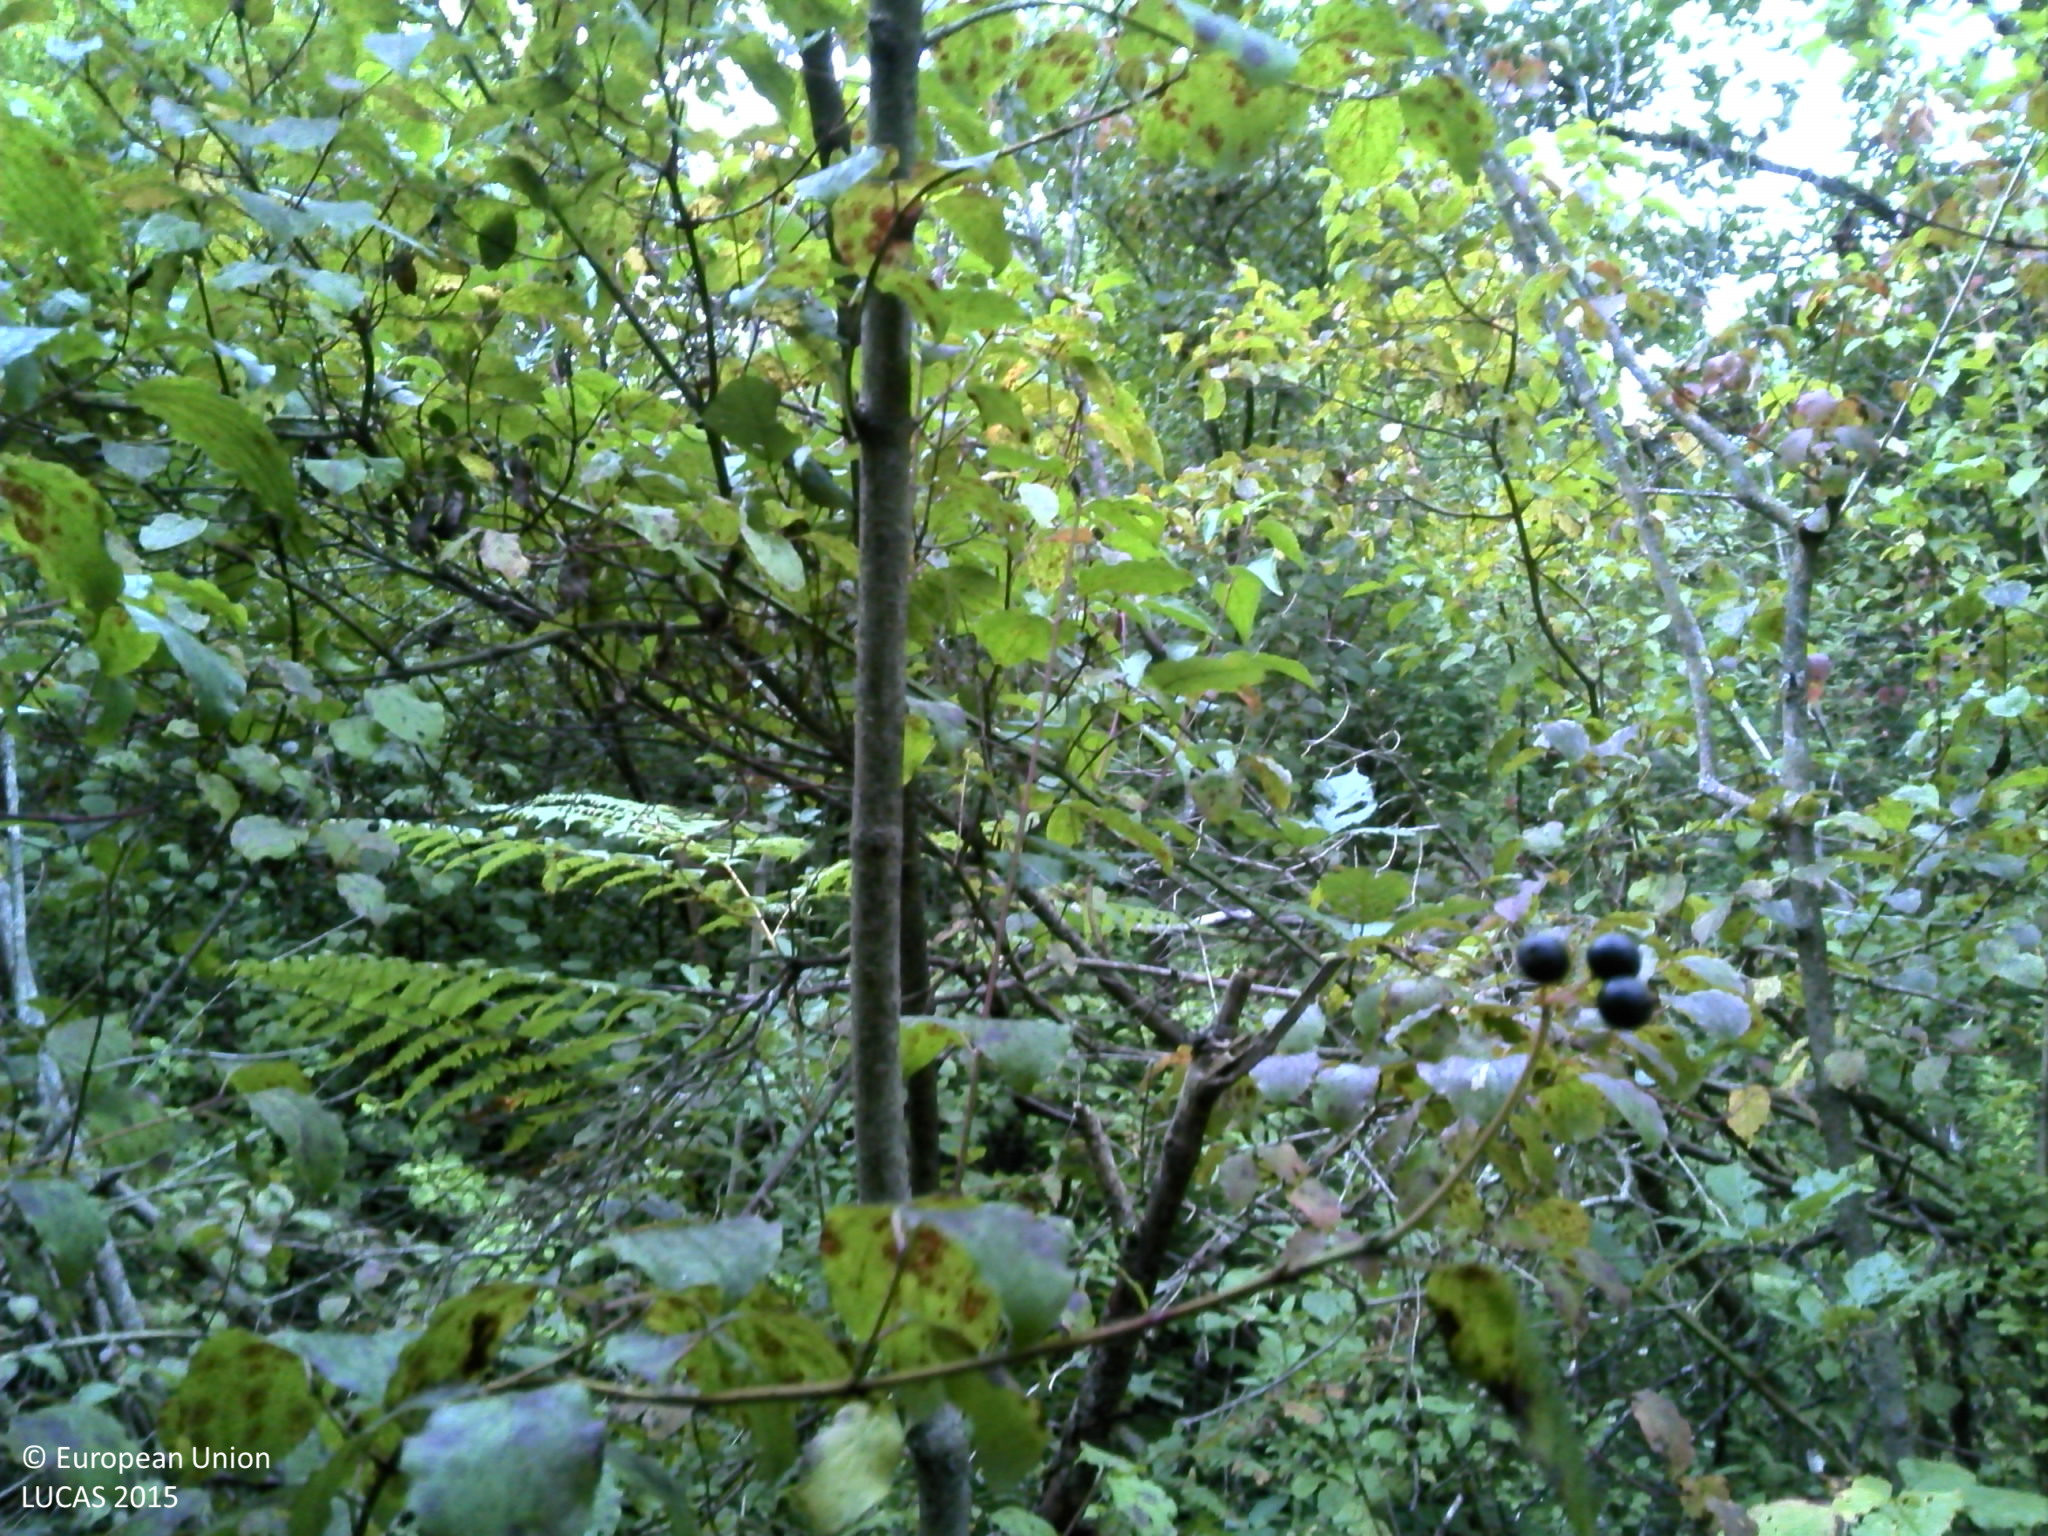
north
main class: Woodland
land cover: Broadleaved woodland
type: mesophytic deciduous forest
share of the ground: > 75 %
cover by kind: broadleaved forest trees 100 %
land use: Forestry
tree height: > 5 m
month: August
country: HR
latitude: 45.3185
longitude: 15.6216
